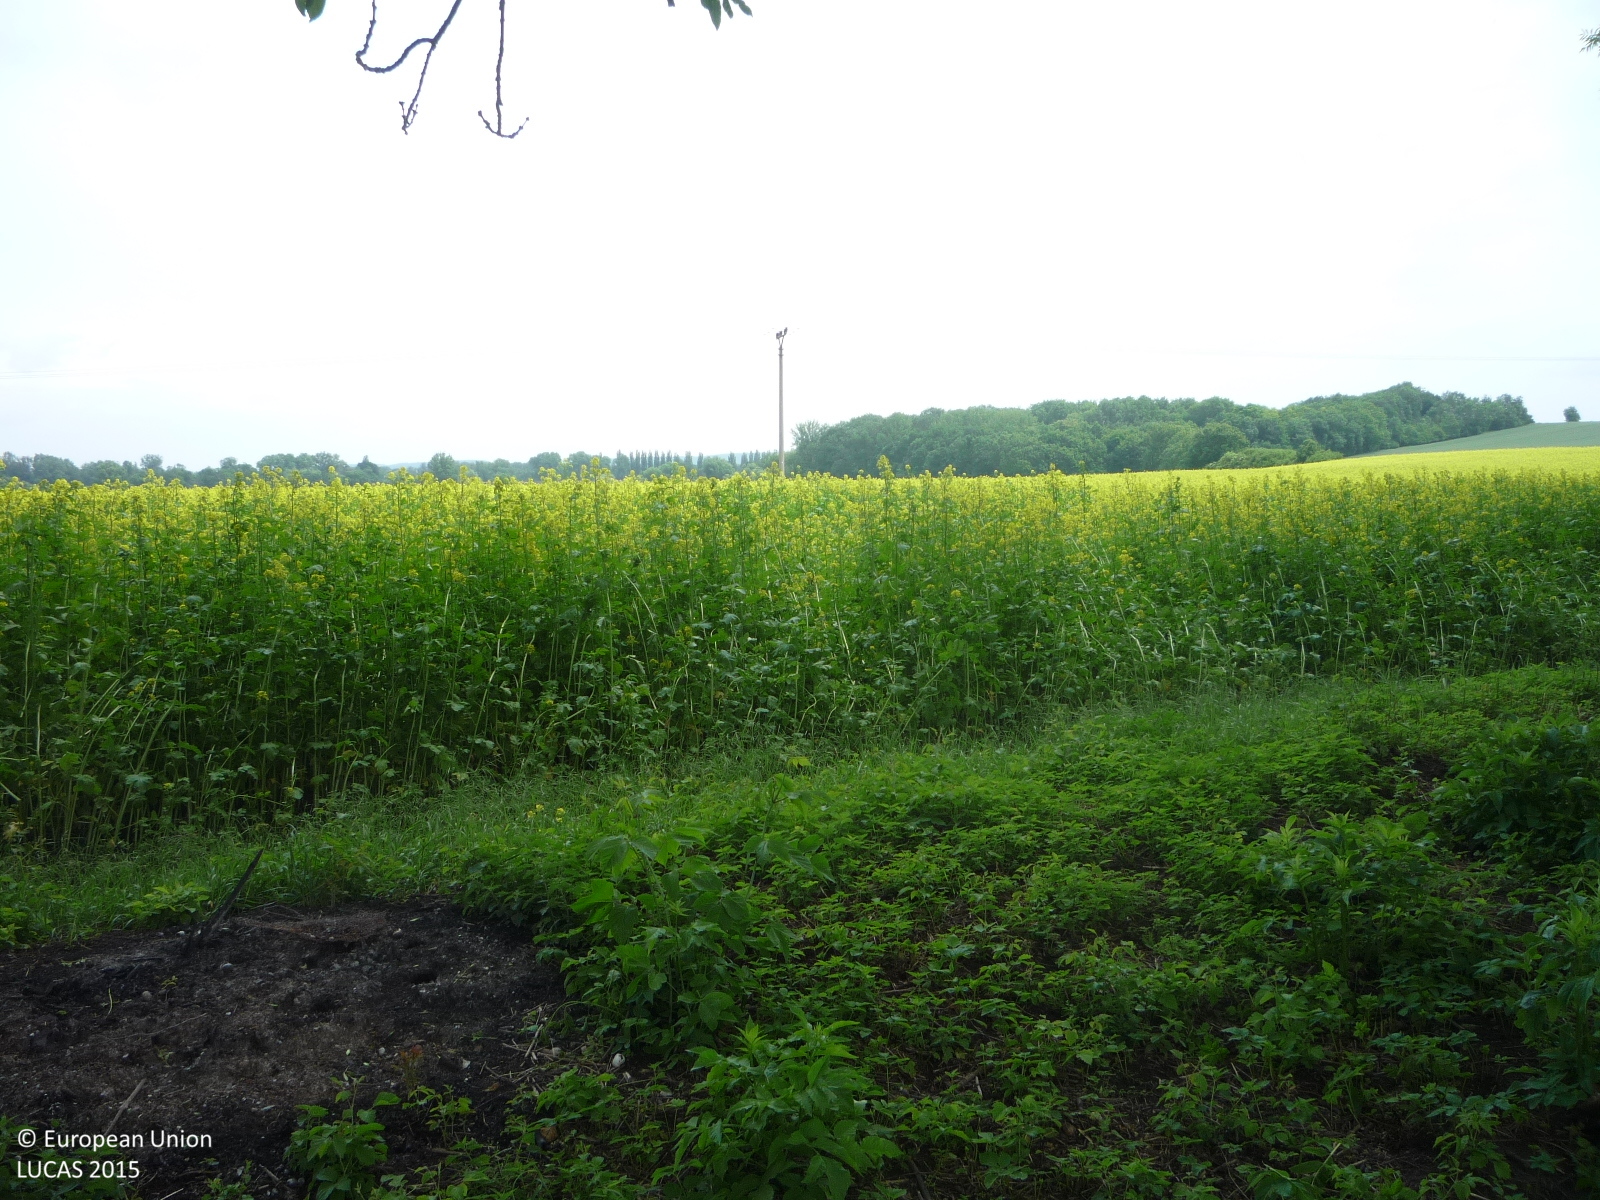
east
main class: Woodland
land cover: Broadleaved woodland
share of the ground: > 75 %
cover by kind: broadleaved forest trees 85 %, herbaceous plants 15 %
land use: Forestry
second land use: Amenities, museums, leisure
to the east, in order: Broadleaved woodland; Other fibre and oleaginous crops; Electric lines; Other fibre and oleaginous crops; Common wheat
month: June
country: CZ
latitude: 50.3707
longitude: 13.8673
